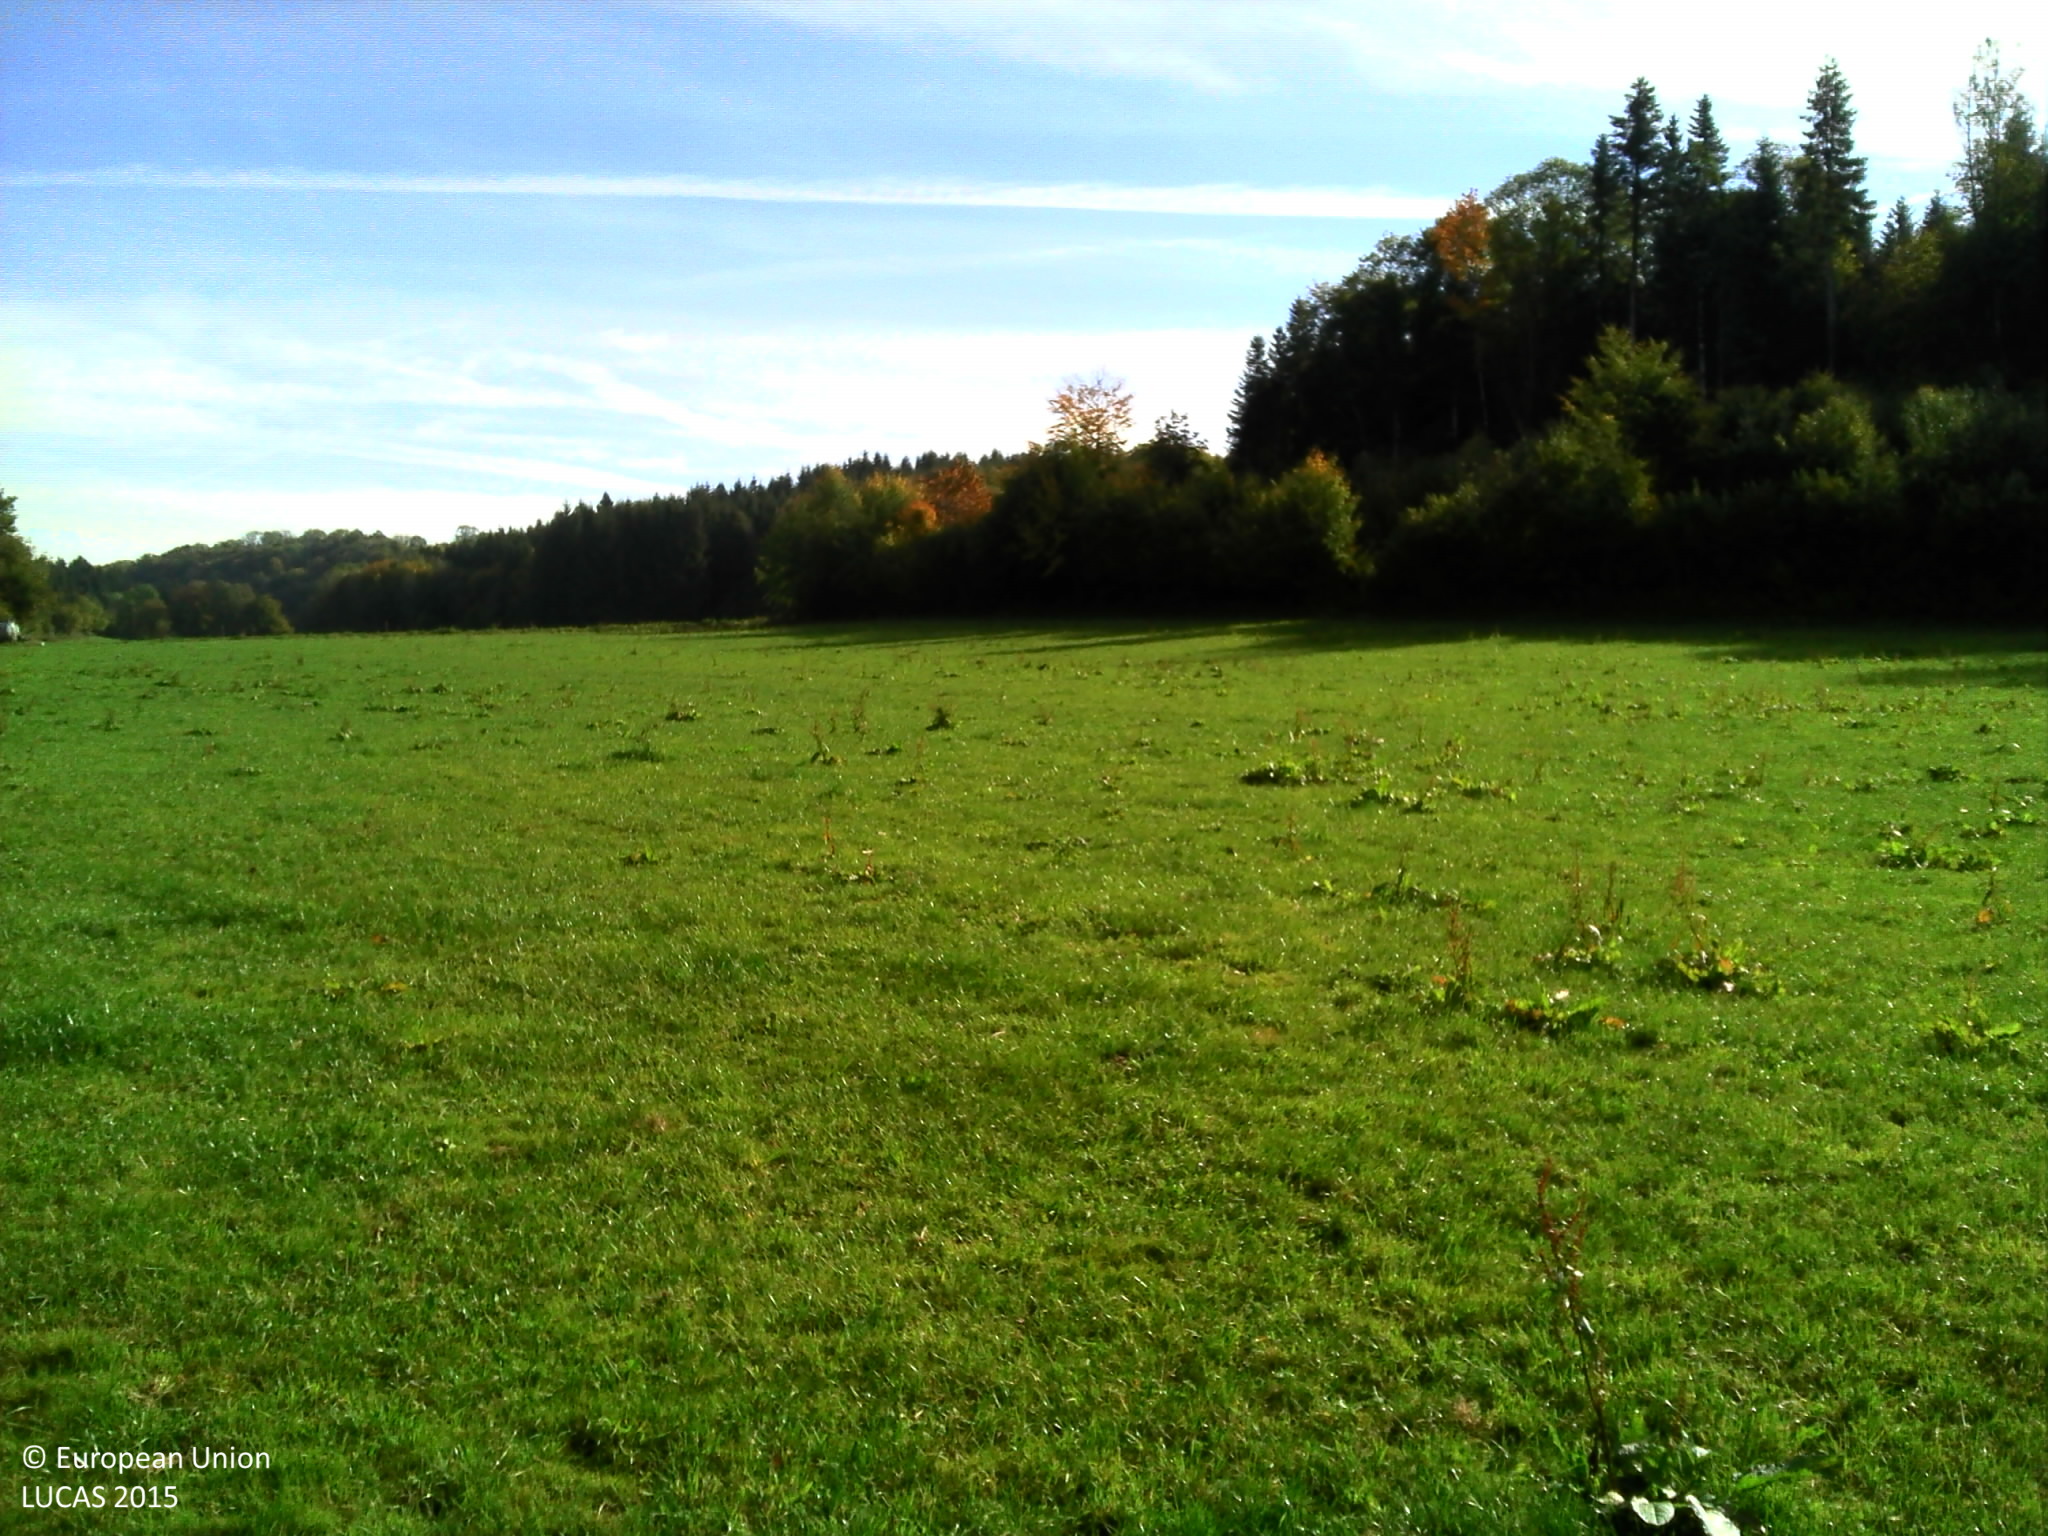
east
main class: Grassland
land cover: Grassland without tree/shrub cover
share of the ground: > 75 %
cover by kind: herbaceous plants 100 %
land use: Agriculture (excluding fallow land and kitchen gardens)
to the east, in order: Grassland without tree/shrub cover; Fences; Broadleaved woodland; Grass margins; Paved roads, cycling and walking lanes; Fences; Grassland without tree/shrub cover; Broadleaved woodland; Grassland without tree/shrub cover
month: October
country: FR
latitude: 47.0625
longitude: 6.3024
